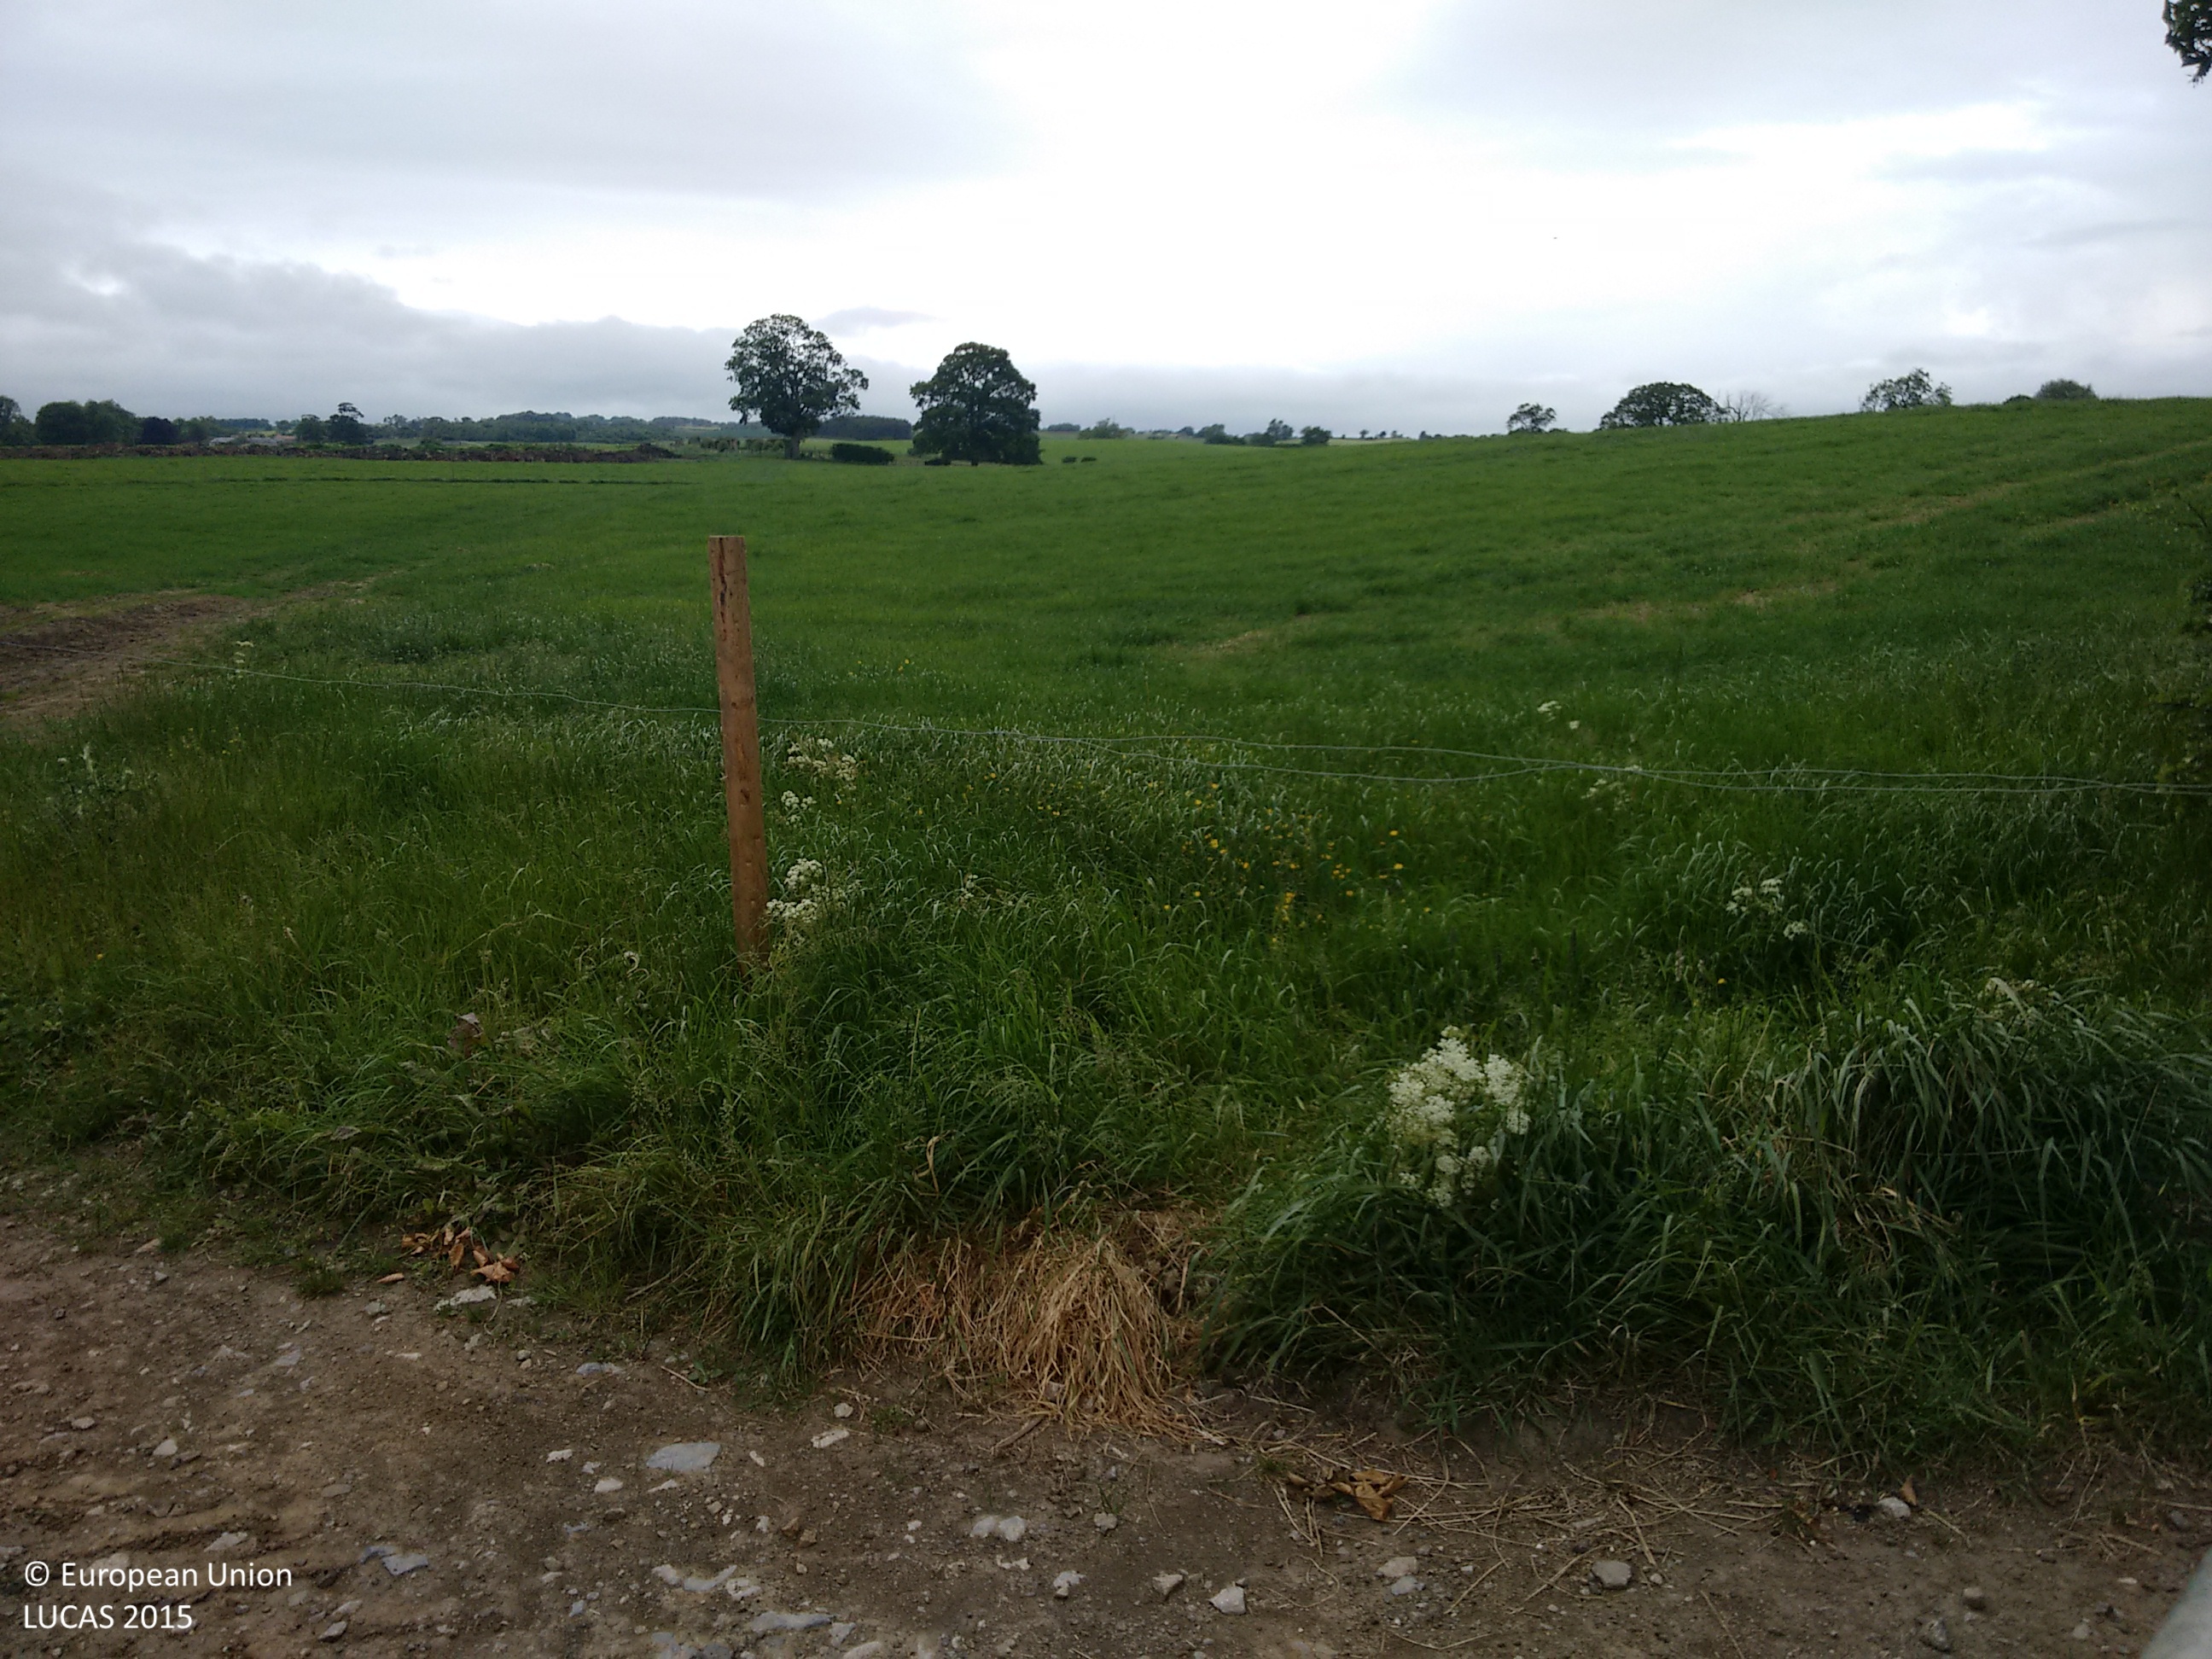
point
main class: Grassland
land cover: Grassland without tree/shrub cover
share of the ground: > 75 %
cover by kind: herbaceous plants 100 %
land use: Agriculture (excluding fallow land and kitchen gardens)
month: June
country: GB
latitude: 54.3474
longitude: -1.6349
